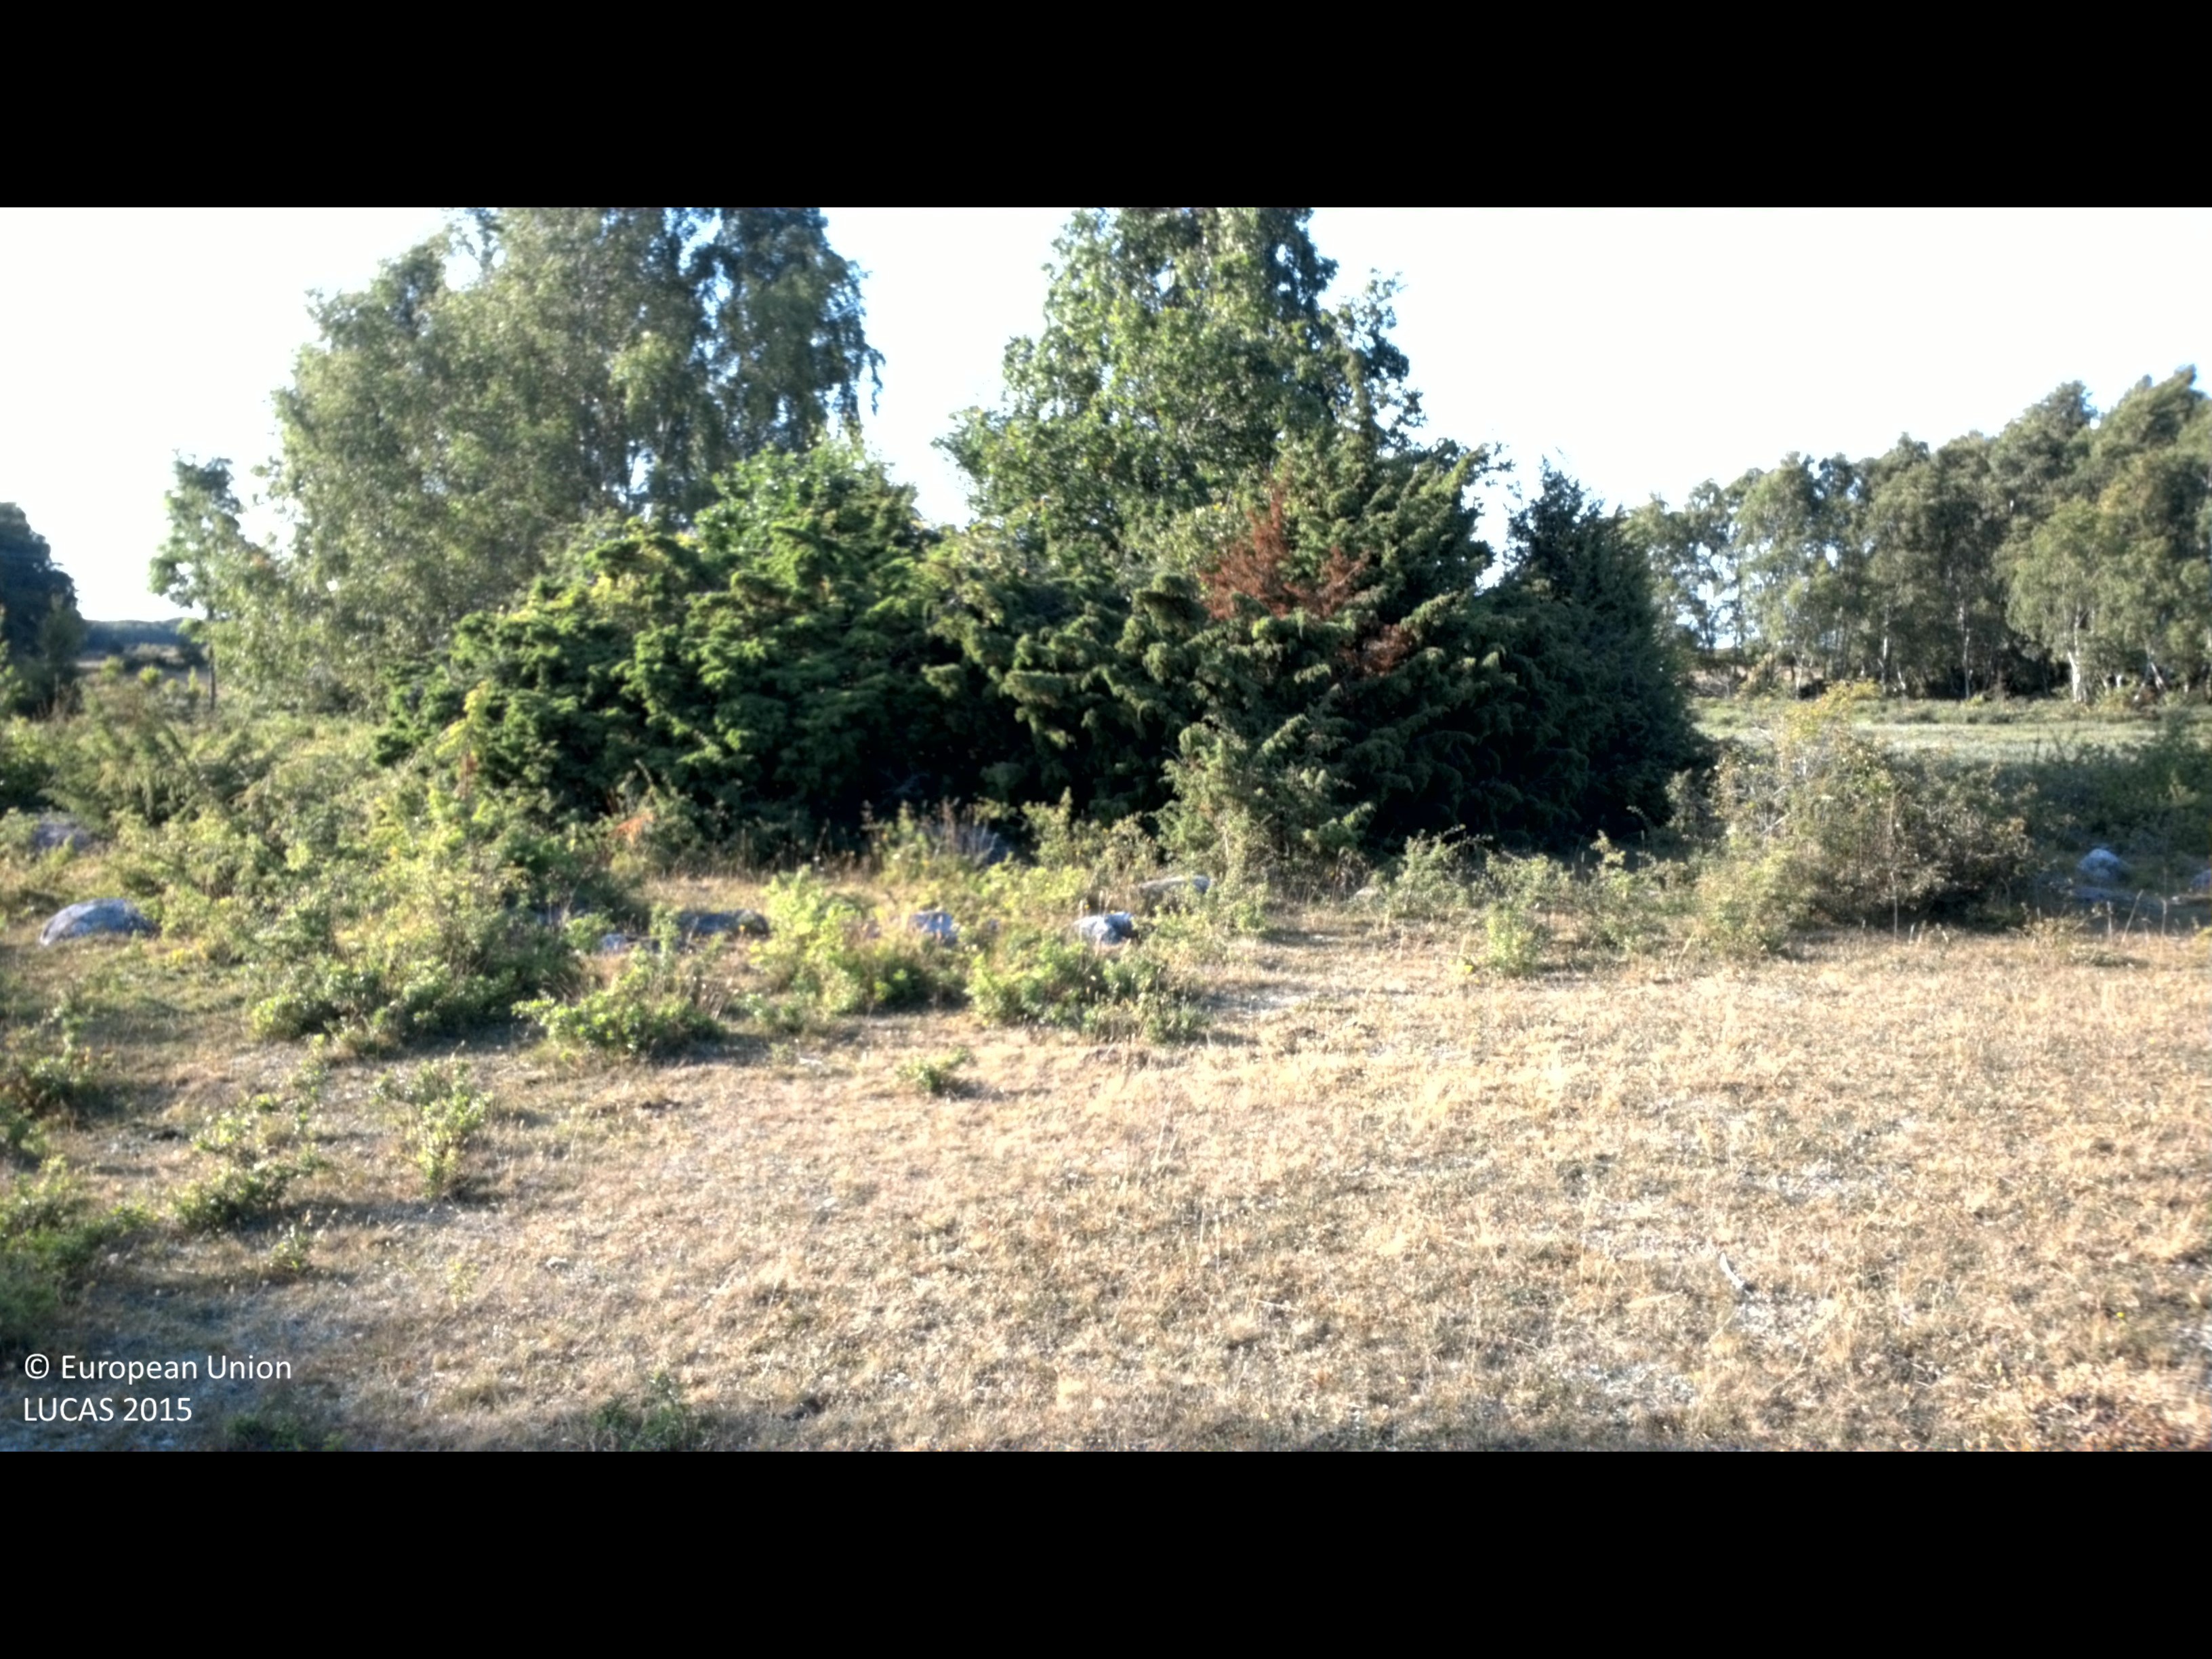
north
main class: Grassland
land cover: Grassland with sparse tree/shrub cover
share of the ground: > 75 %
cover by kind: herbaceous plants 90 %, broadleaved forest trees 5 %, shrubs 5 %
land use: Agriculture (excluding fallow land and kitchen gardens)
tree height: < 5 m
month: July
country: SE
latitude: 56.3157
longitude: 16.4202
